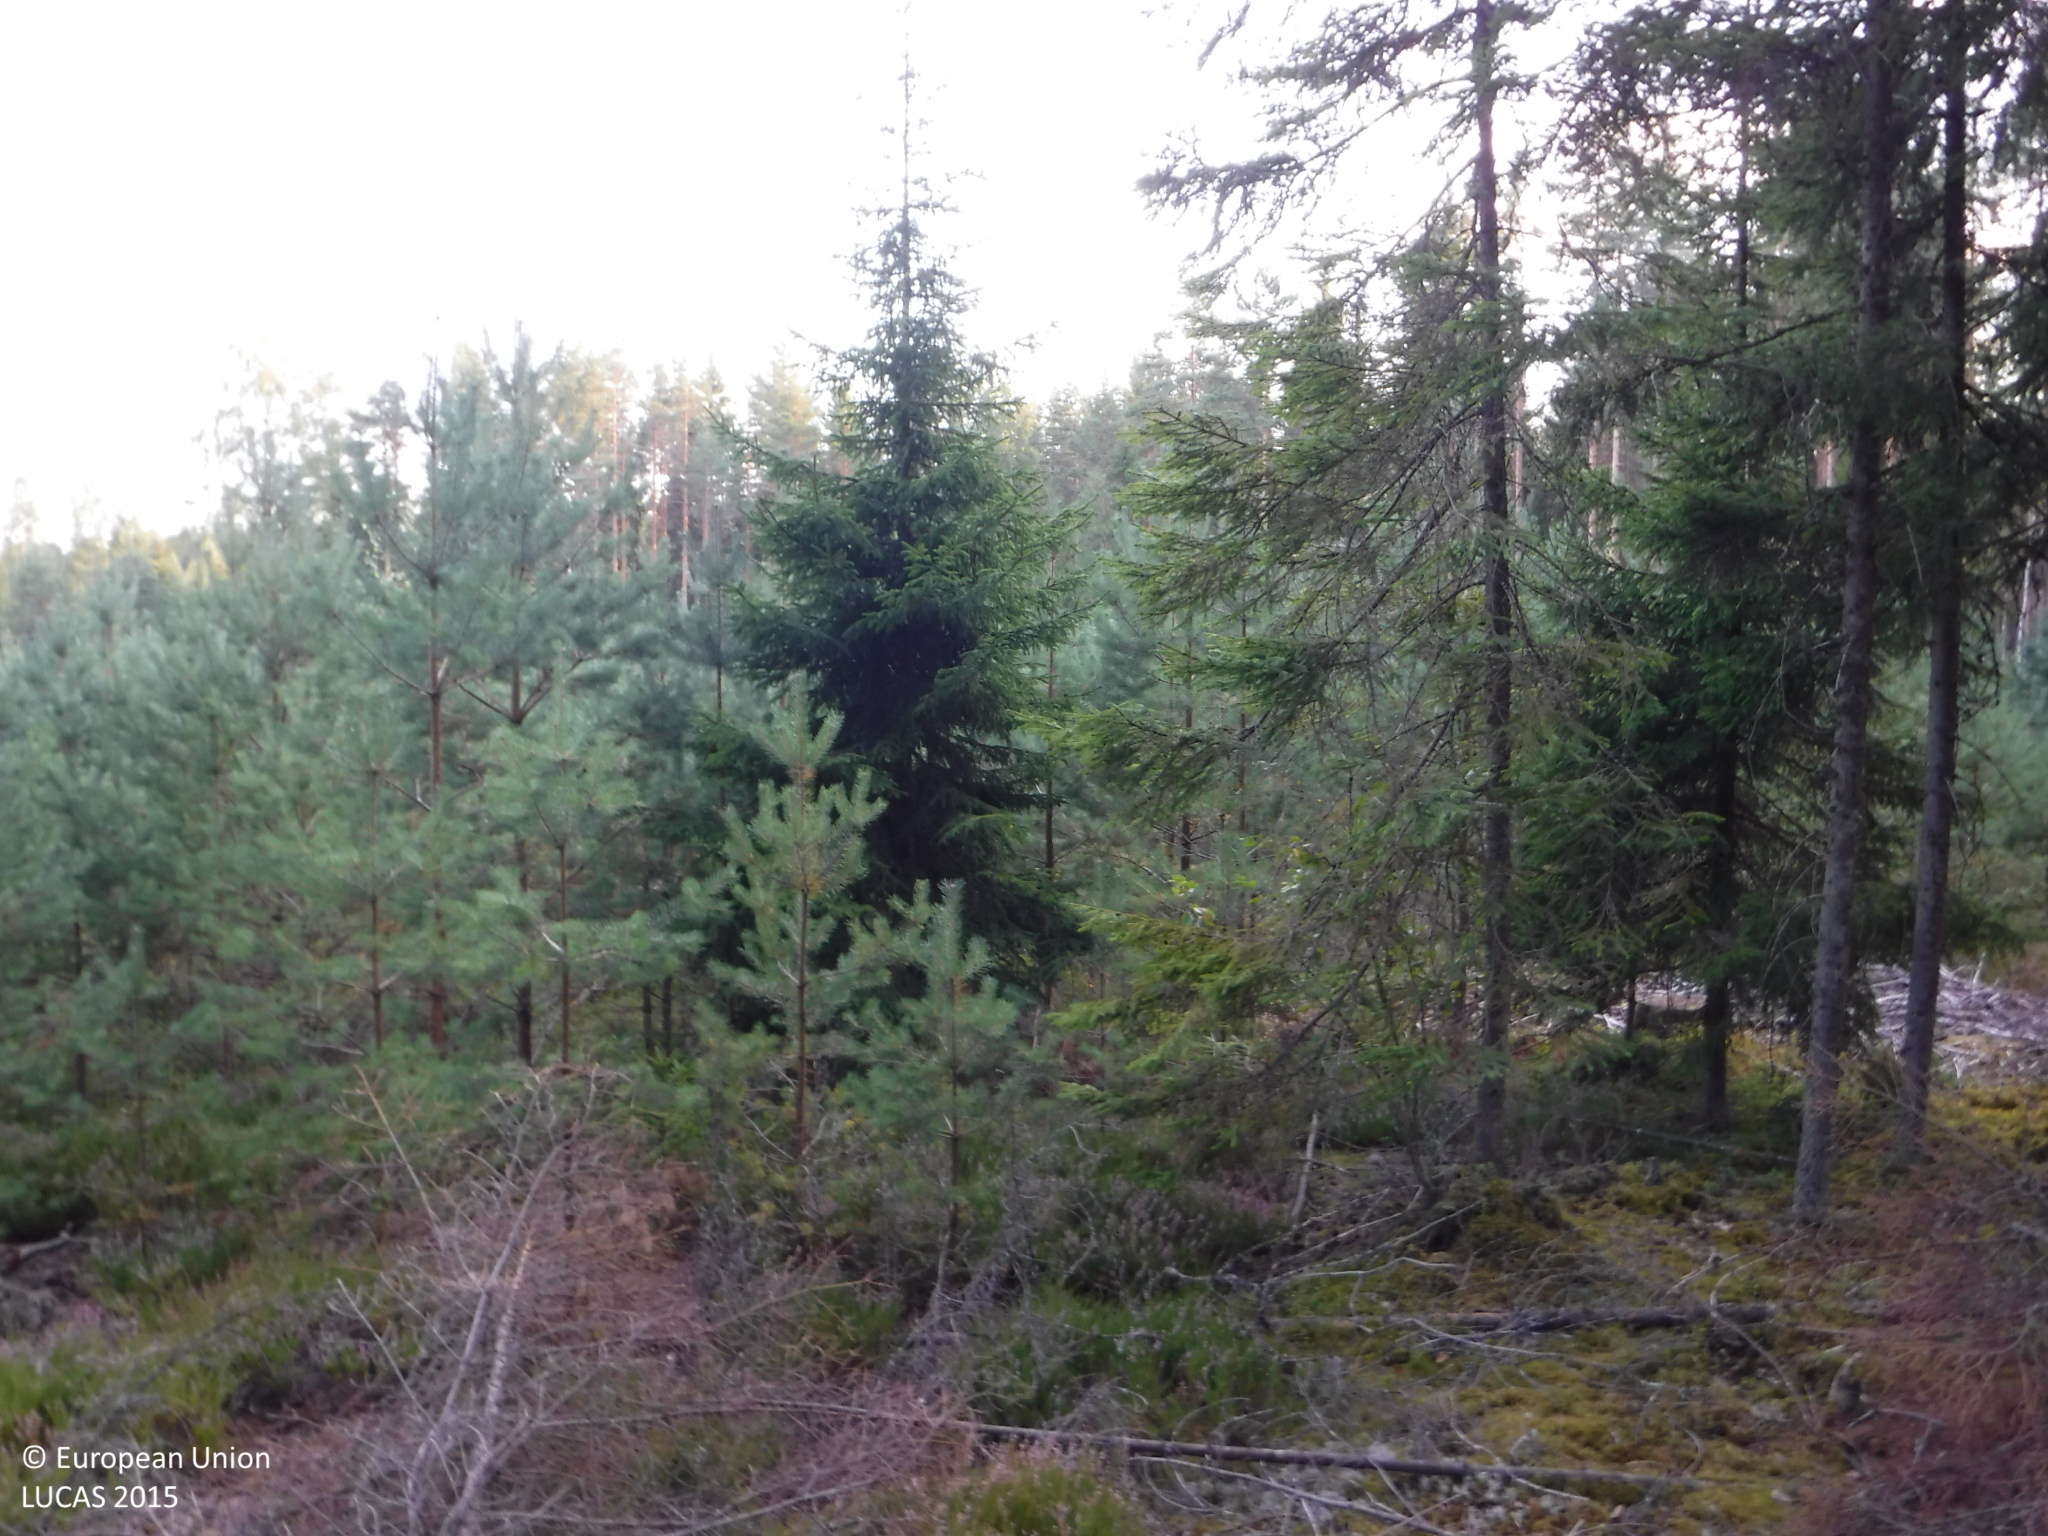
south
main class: Woodland
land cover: Other coniferous woodland
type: boreal forest
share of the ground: 25 - 50 %
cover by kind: coniferous forest trees 50 %, shrubs 30 %, lichens and mosses 20 %
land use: Forestry
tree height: > 5 m
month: August
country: FI
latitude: 61.1610
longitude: 23.0654
